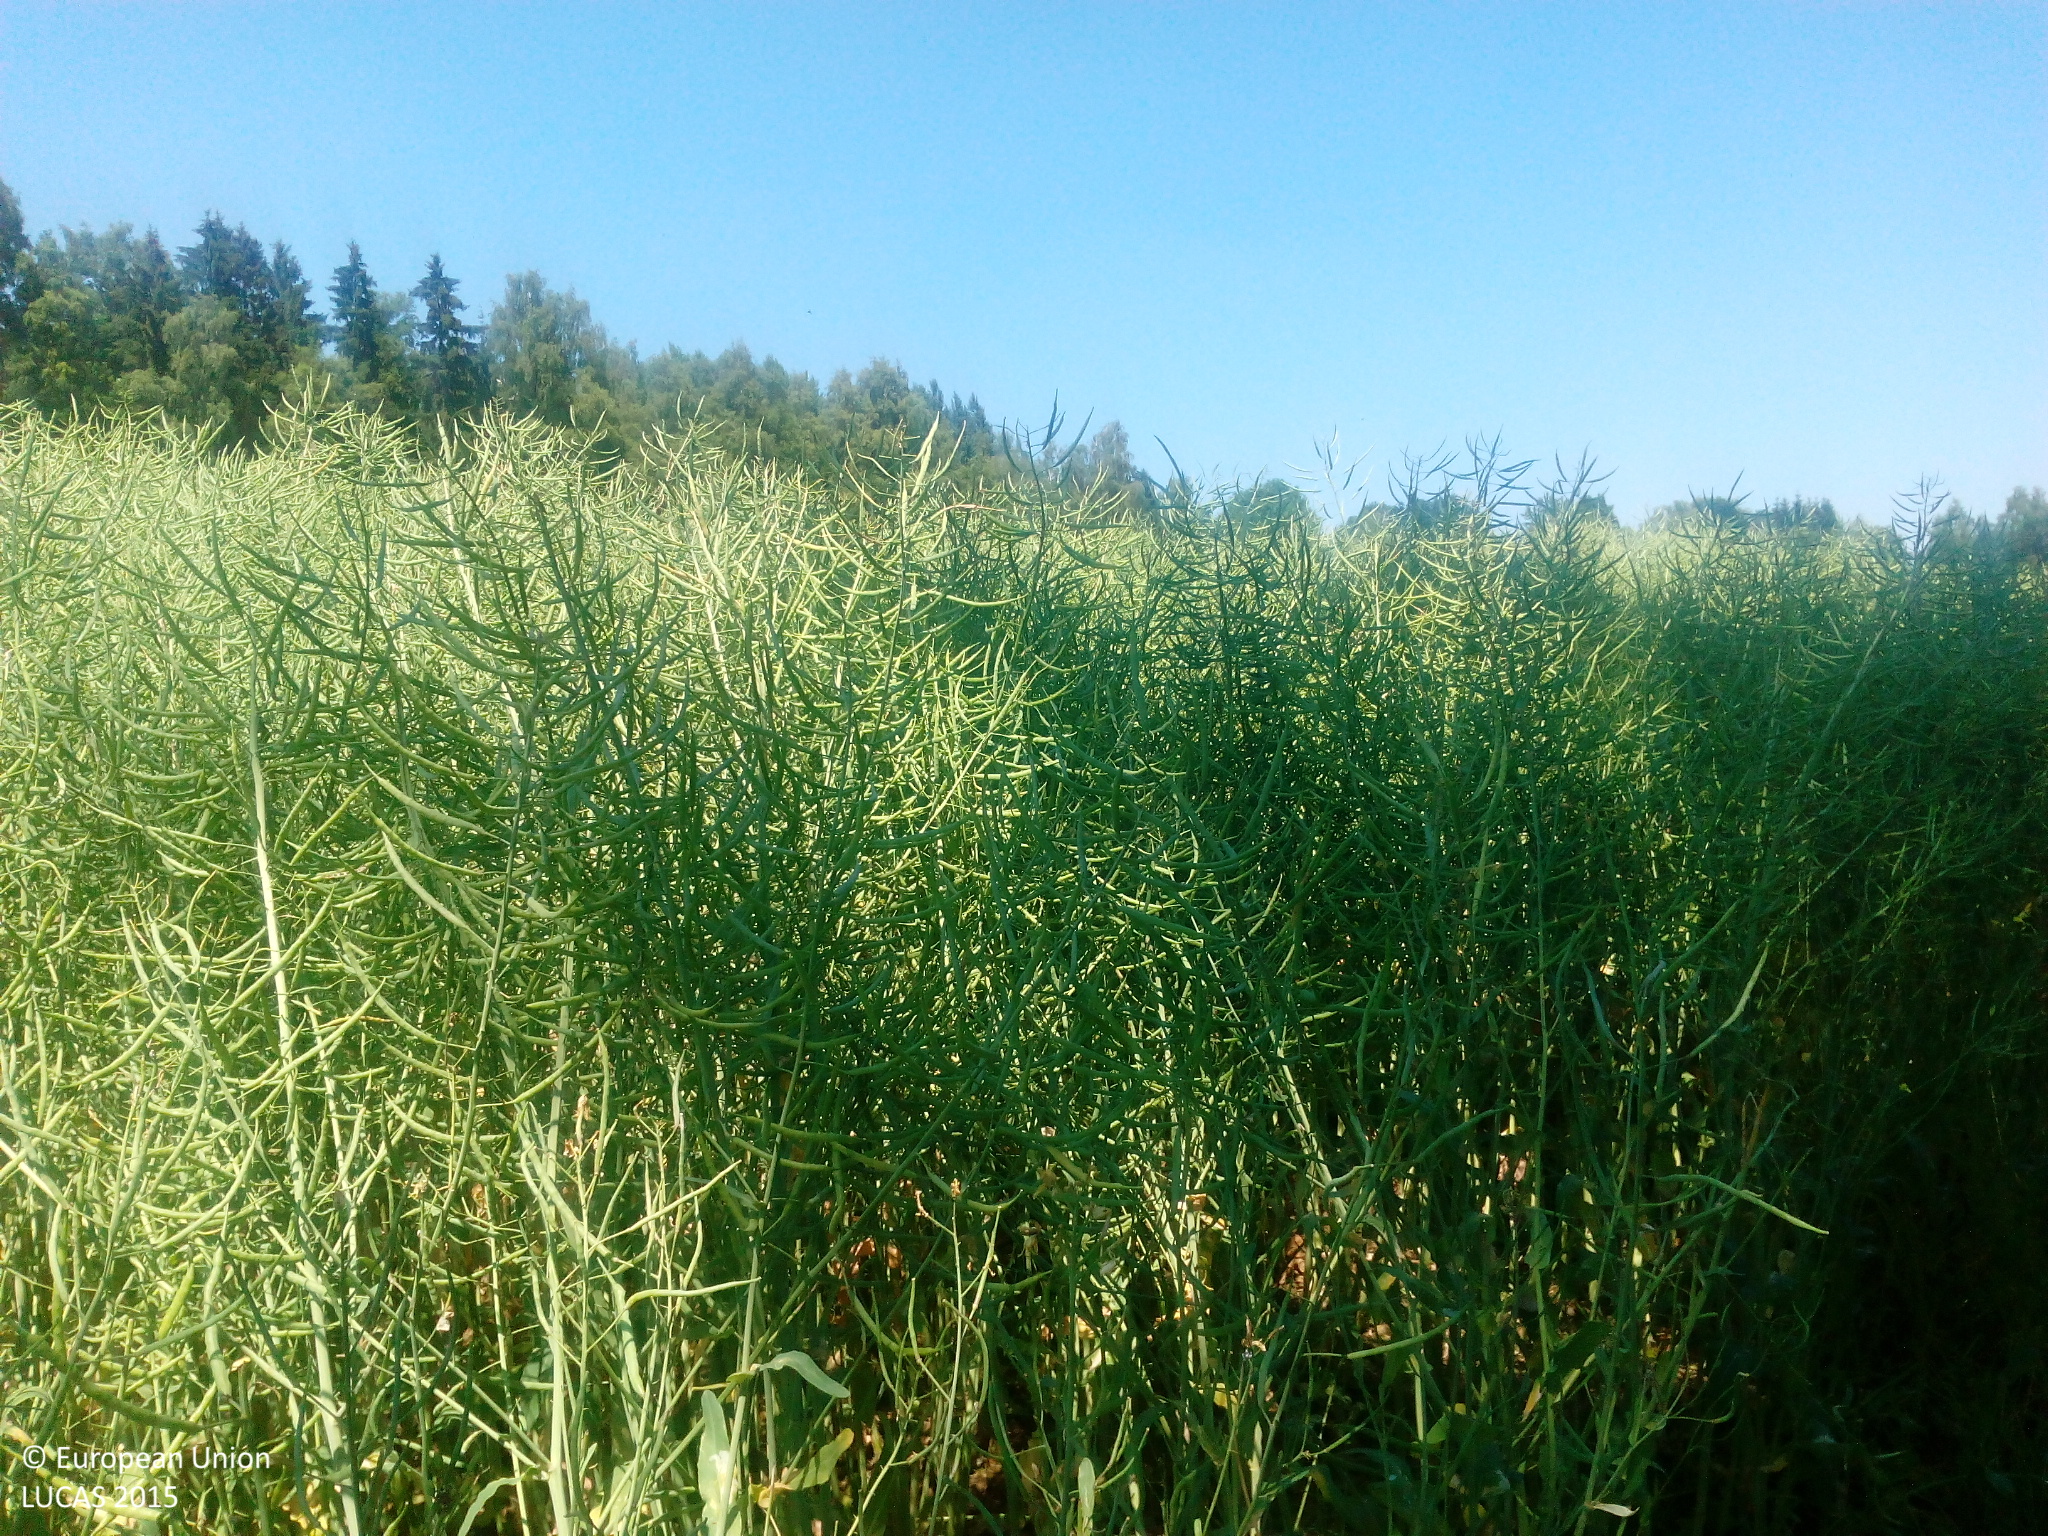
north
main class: Cropland
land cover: Rape and turnip rape
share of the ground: > 75 %
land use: Agriculture (excluding fallow land and kitchen gardens)
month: July
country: DE
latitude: 50.2084
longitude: 11.6390
